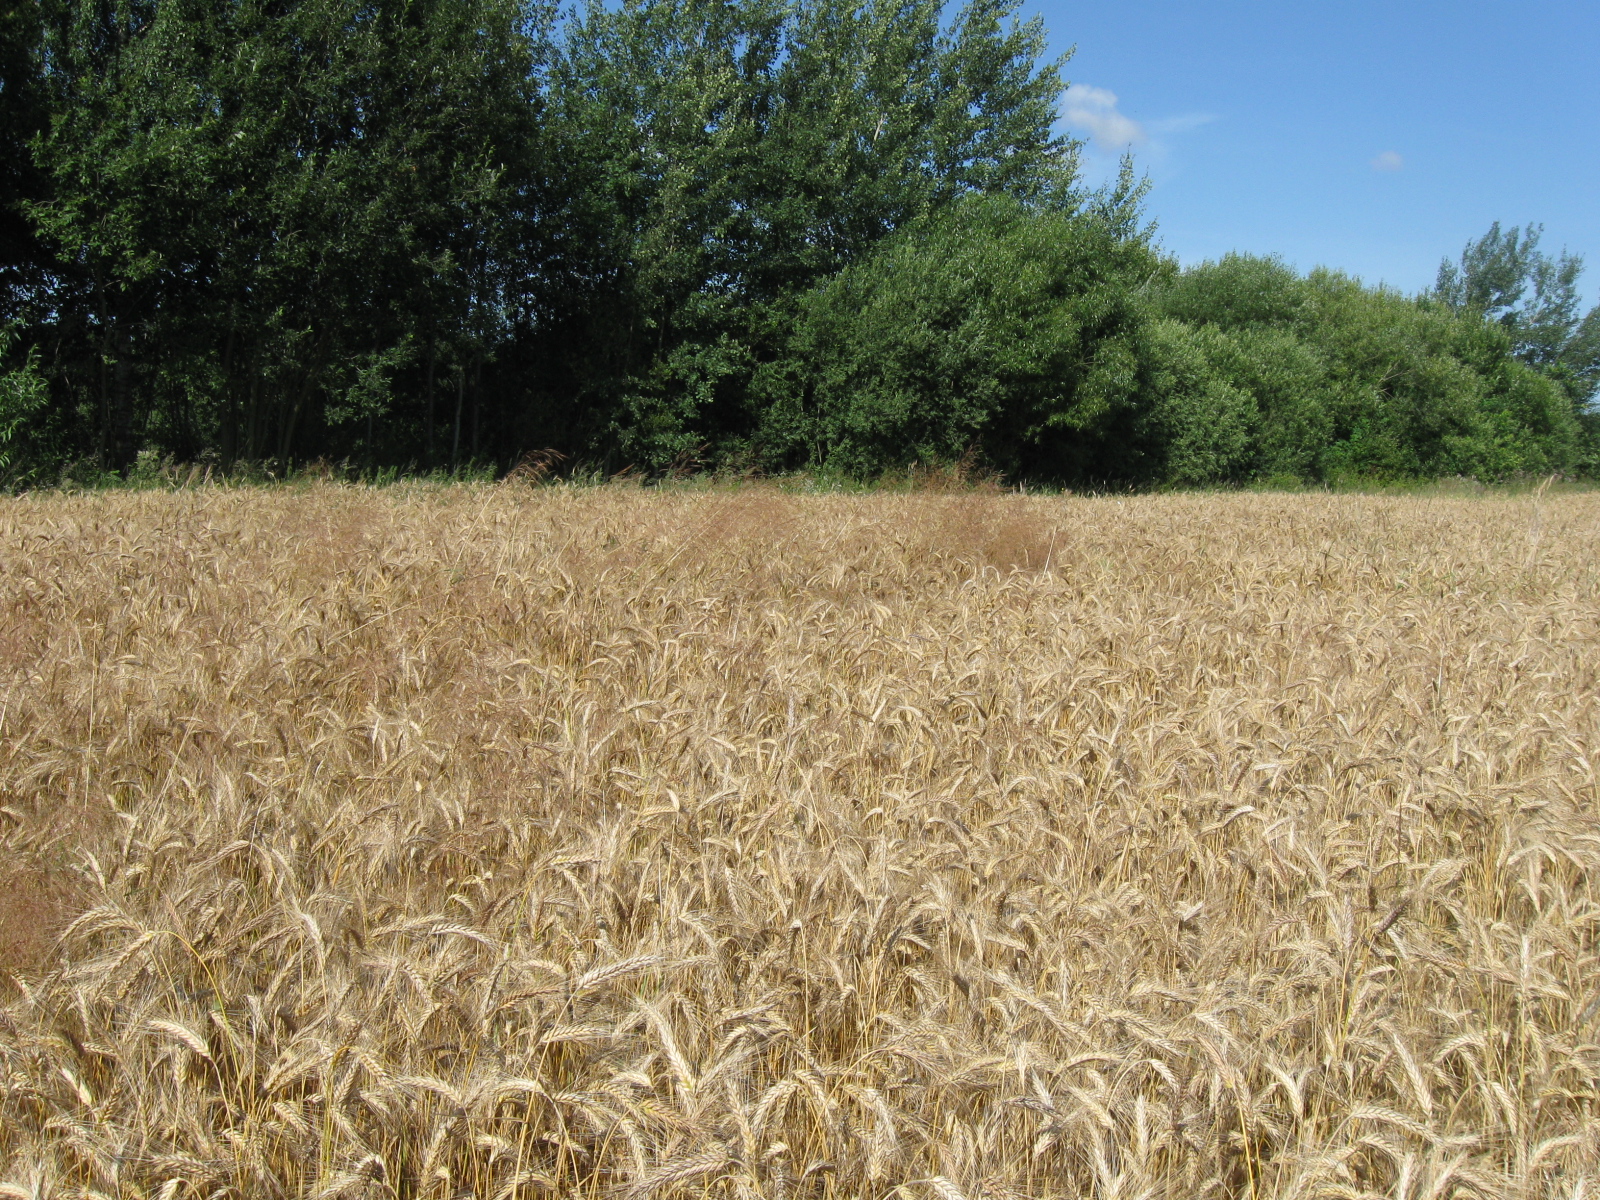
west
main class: Cropland
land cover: Durum wheat
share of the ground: > 75 %
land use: Agriculture (excluding fallow land and kitchen gardens)
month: July
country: LT
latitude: 55.0296
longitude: 23.5196
